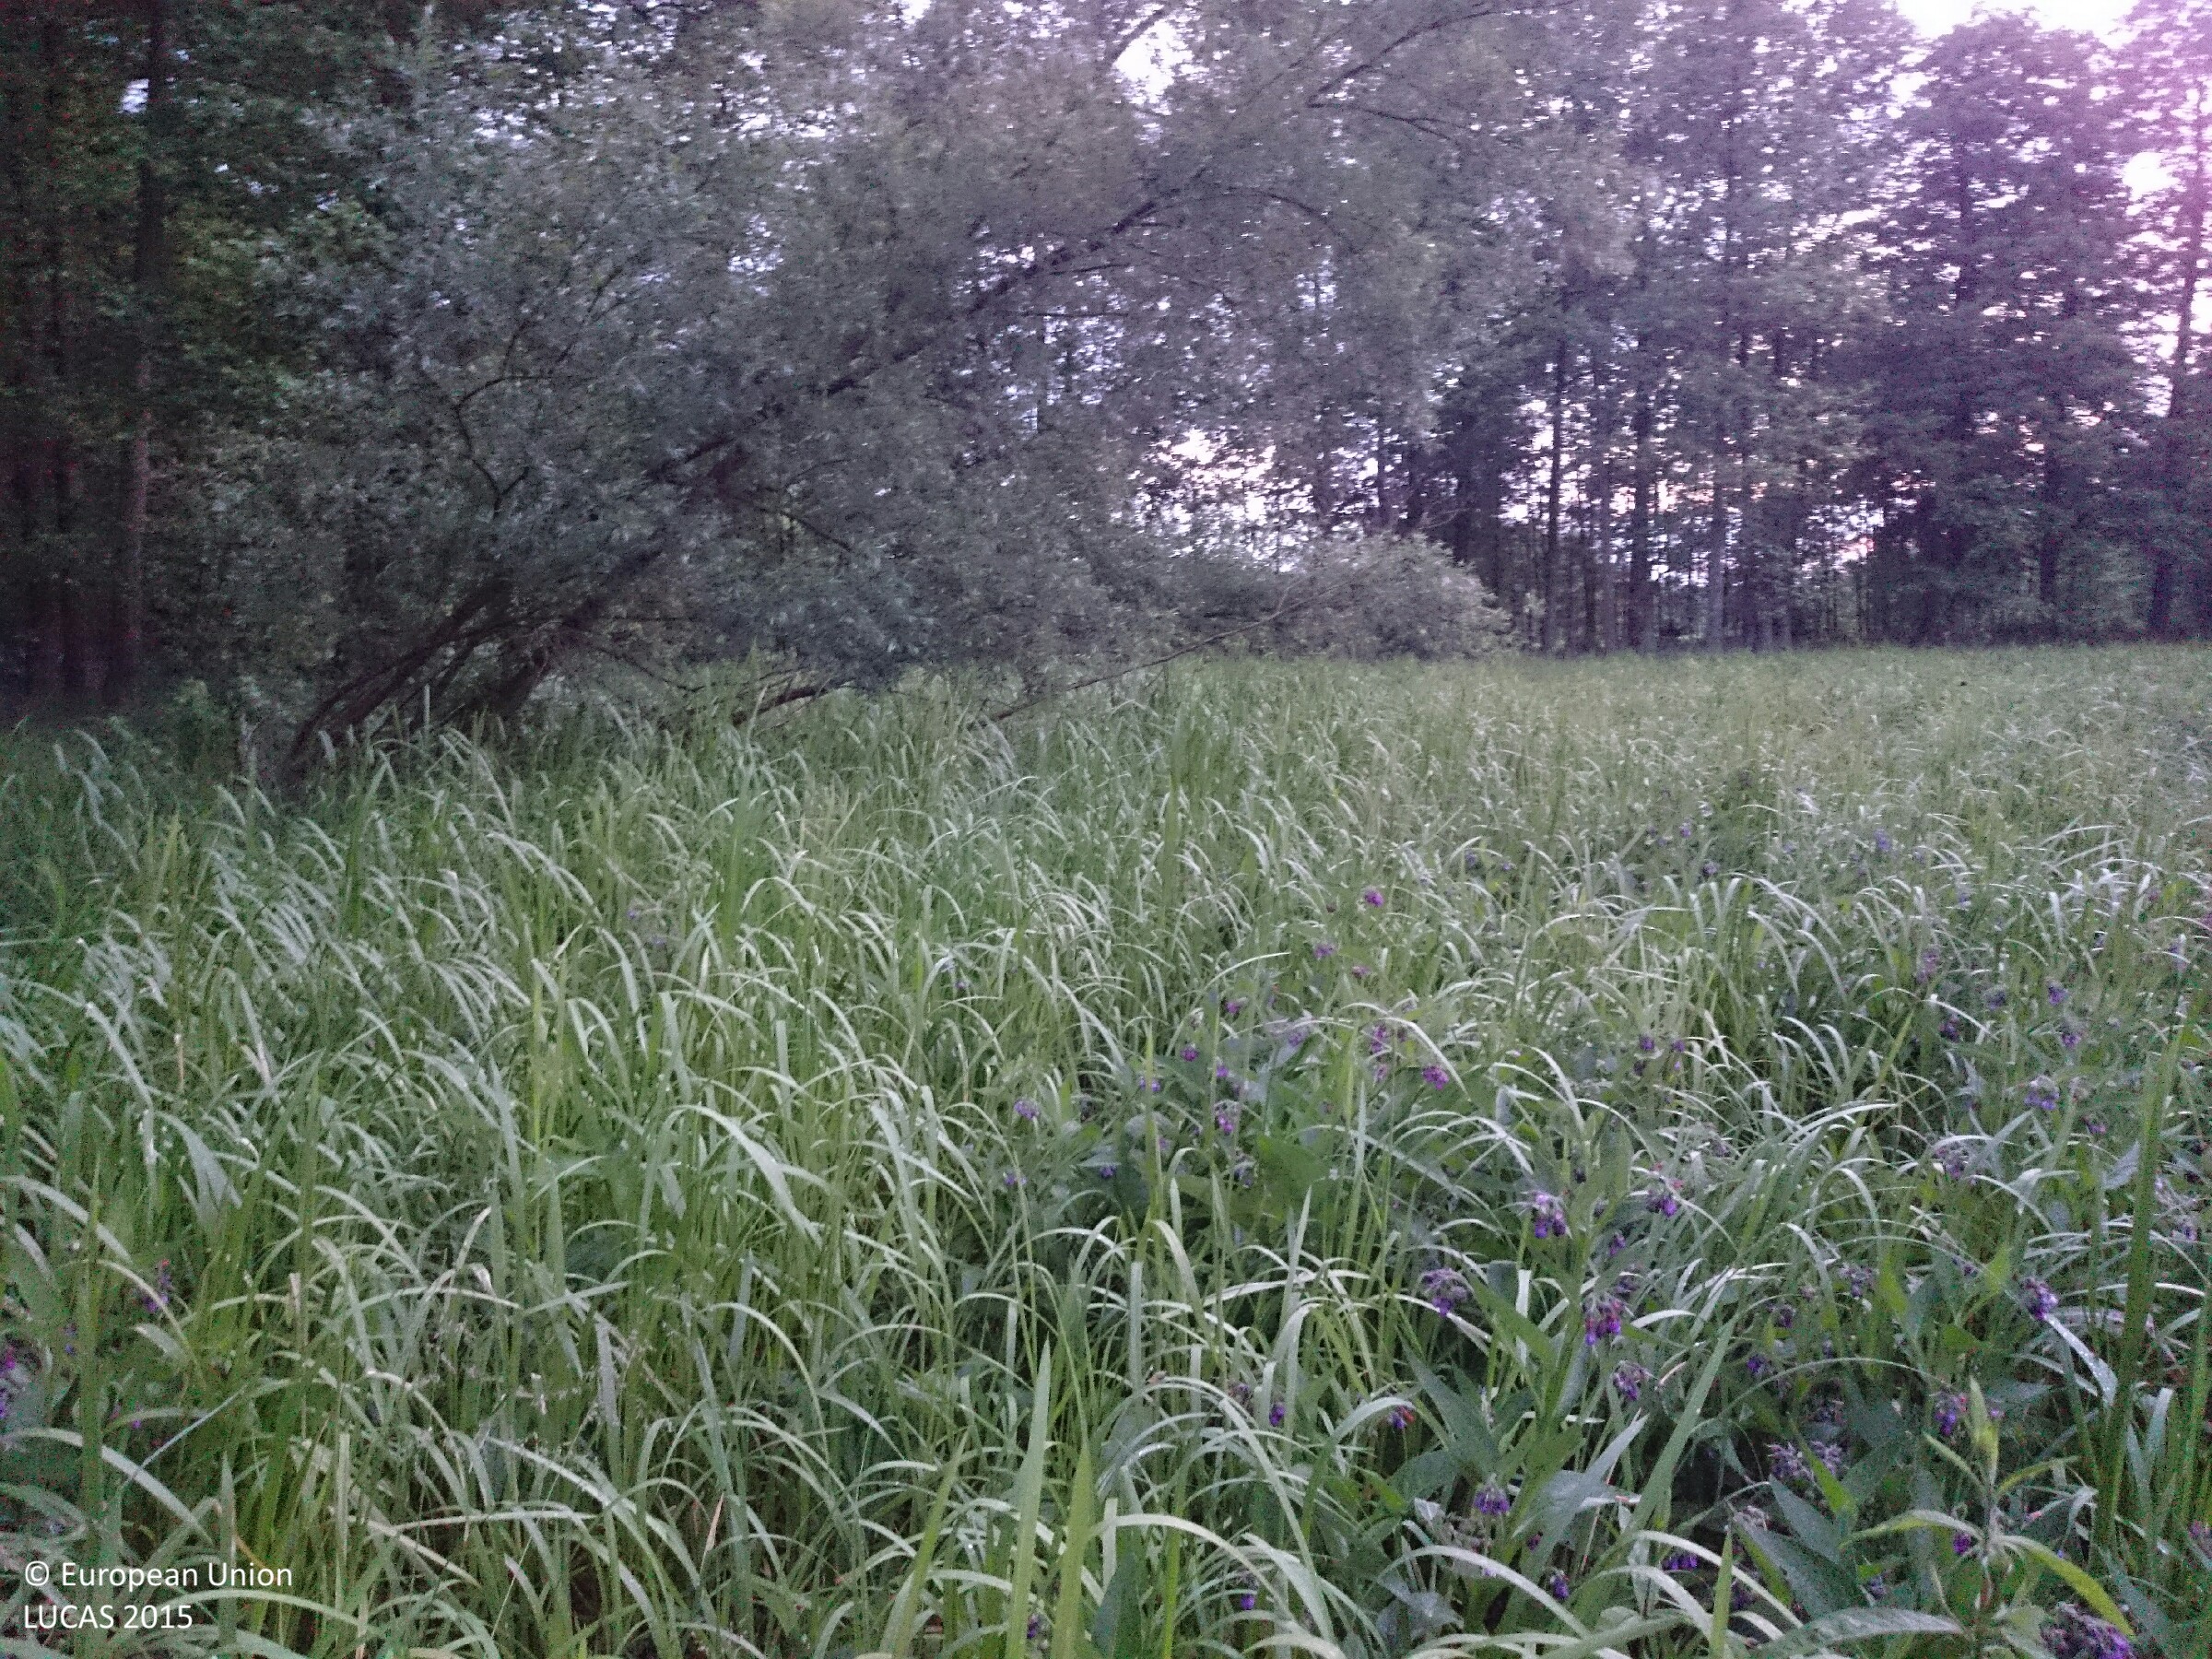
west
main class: Grassland
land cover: Grassland without tree/shrub cover
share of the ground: > 75 %
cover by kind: herbaceous plants 100 %
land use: Forestry
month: June
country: PL
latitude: 52.7641
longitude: 15.6803
